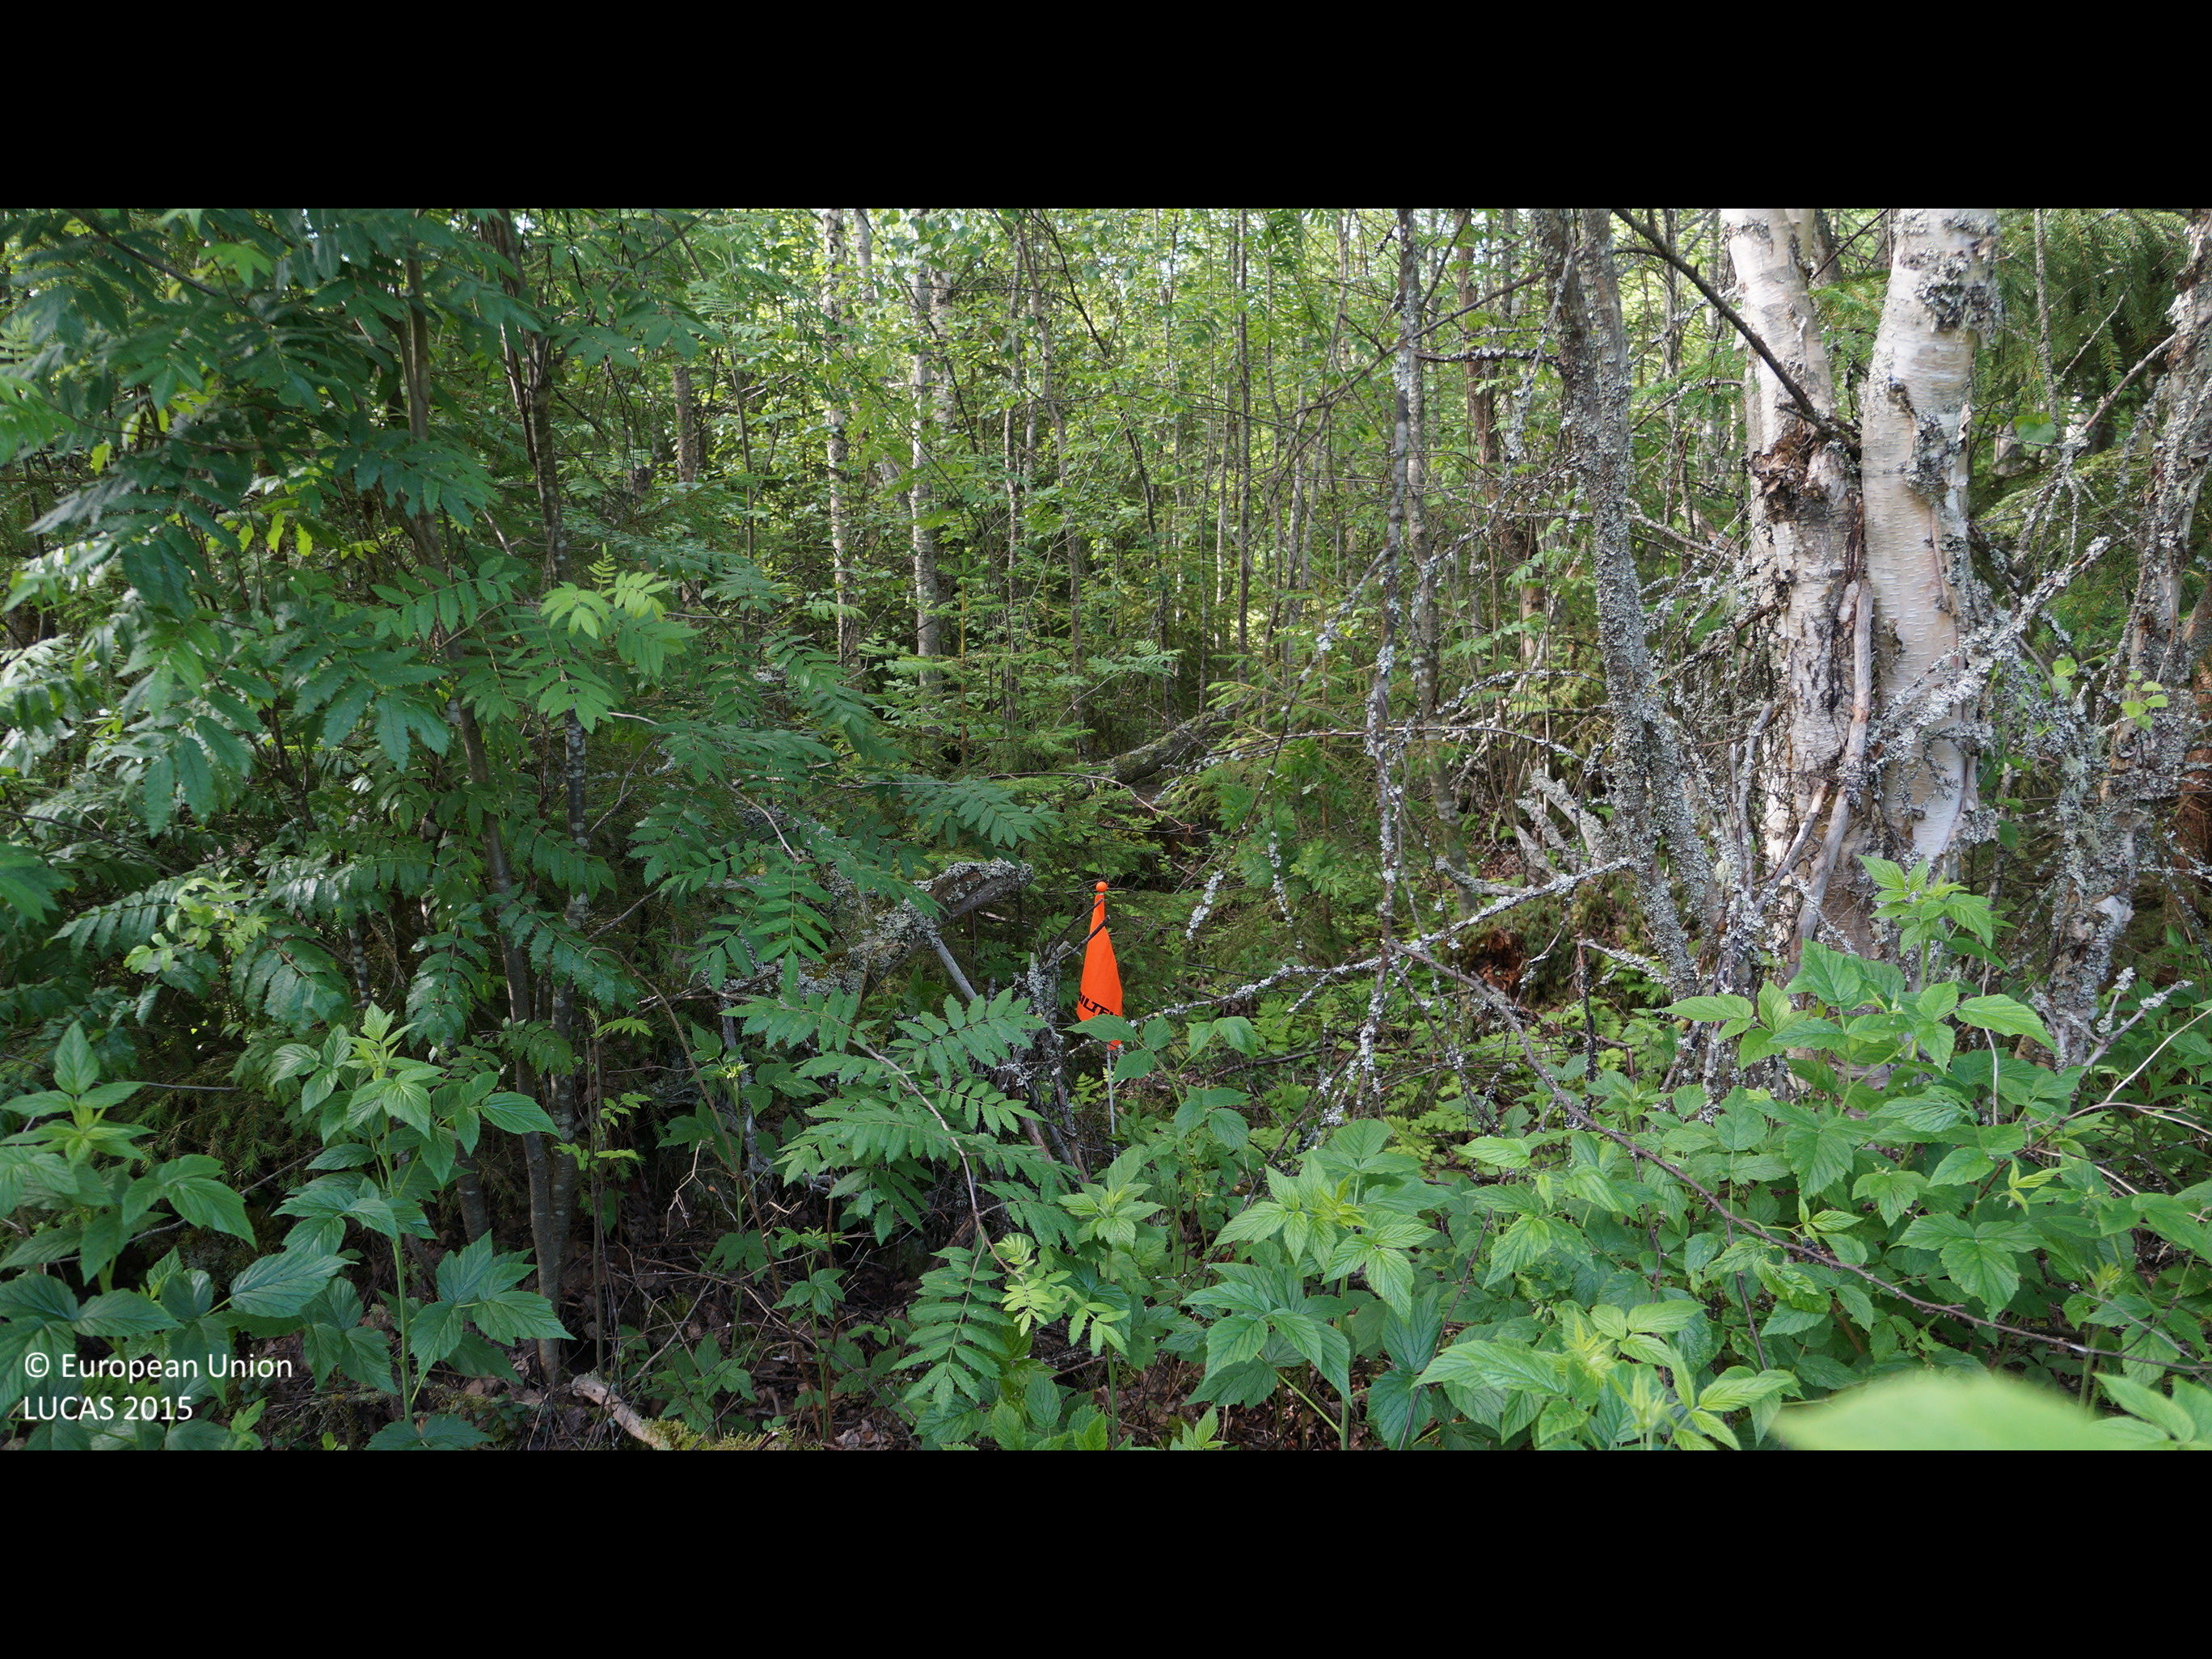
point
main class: Woodland
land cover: Broadleaved woodland
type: boreal forest
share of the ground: > 75 %
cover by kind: broadleaved forest trees 65 %, coniferous forest trees 15 %, shrubs 10 %, herbaceous plants 10 %
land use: Forestry
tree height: > 5 m
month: July
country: FI
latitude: 64.3185
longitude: 24.4859
